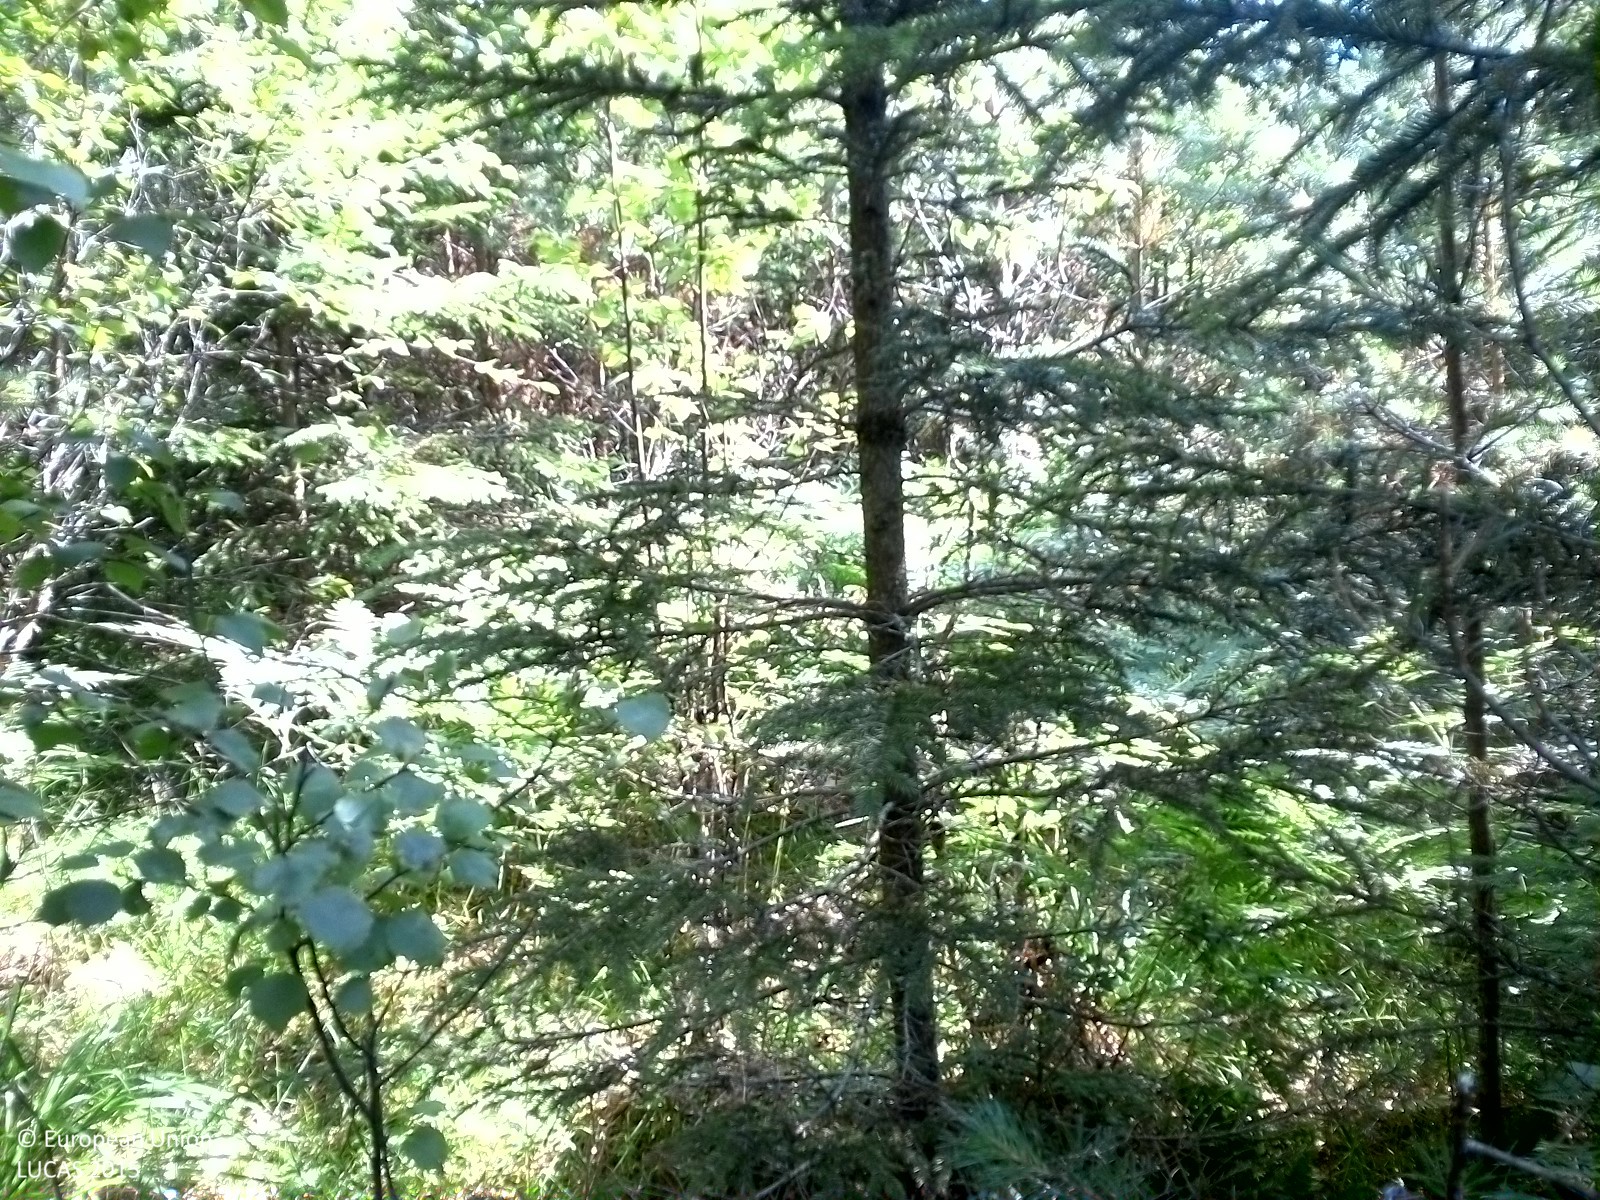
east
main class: Woodland
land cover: Other mixed woodland
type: boreal forest
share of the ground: > 75 %
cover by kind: coniferous forest trees 45 %, broadleaved forest trees 35 %, herbaceous plants 20 %
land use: Forestry
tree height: < 5 m
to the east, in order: Other mixed woodland; Pine dominated mixed woodland
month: August
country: SE
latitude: 58.8691
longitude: 15.3862
